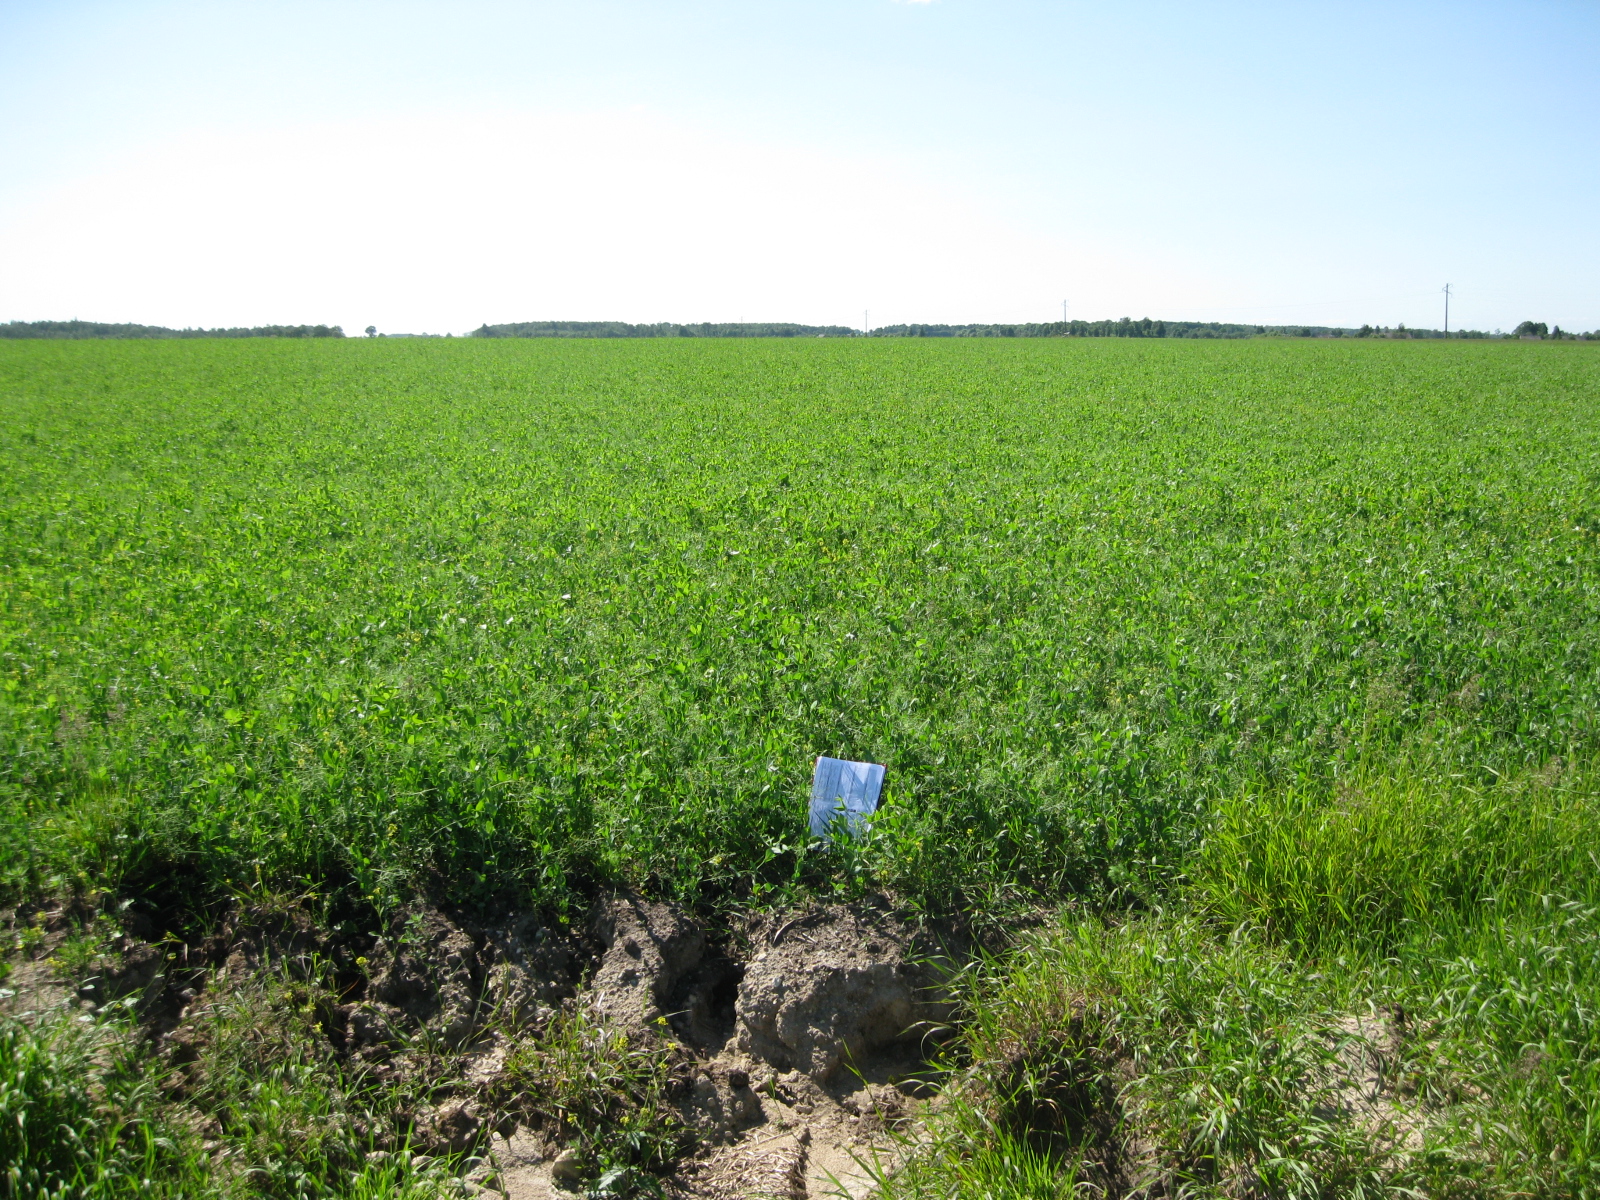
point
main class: Cropland
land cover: Dry pulses
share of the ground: > 75 %
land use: Agriculture (excluding fallow land and kitchen gardens)
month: June
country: LT
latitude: 55.2801
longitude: 23.7336
